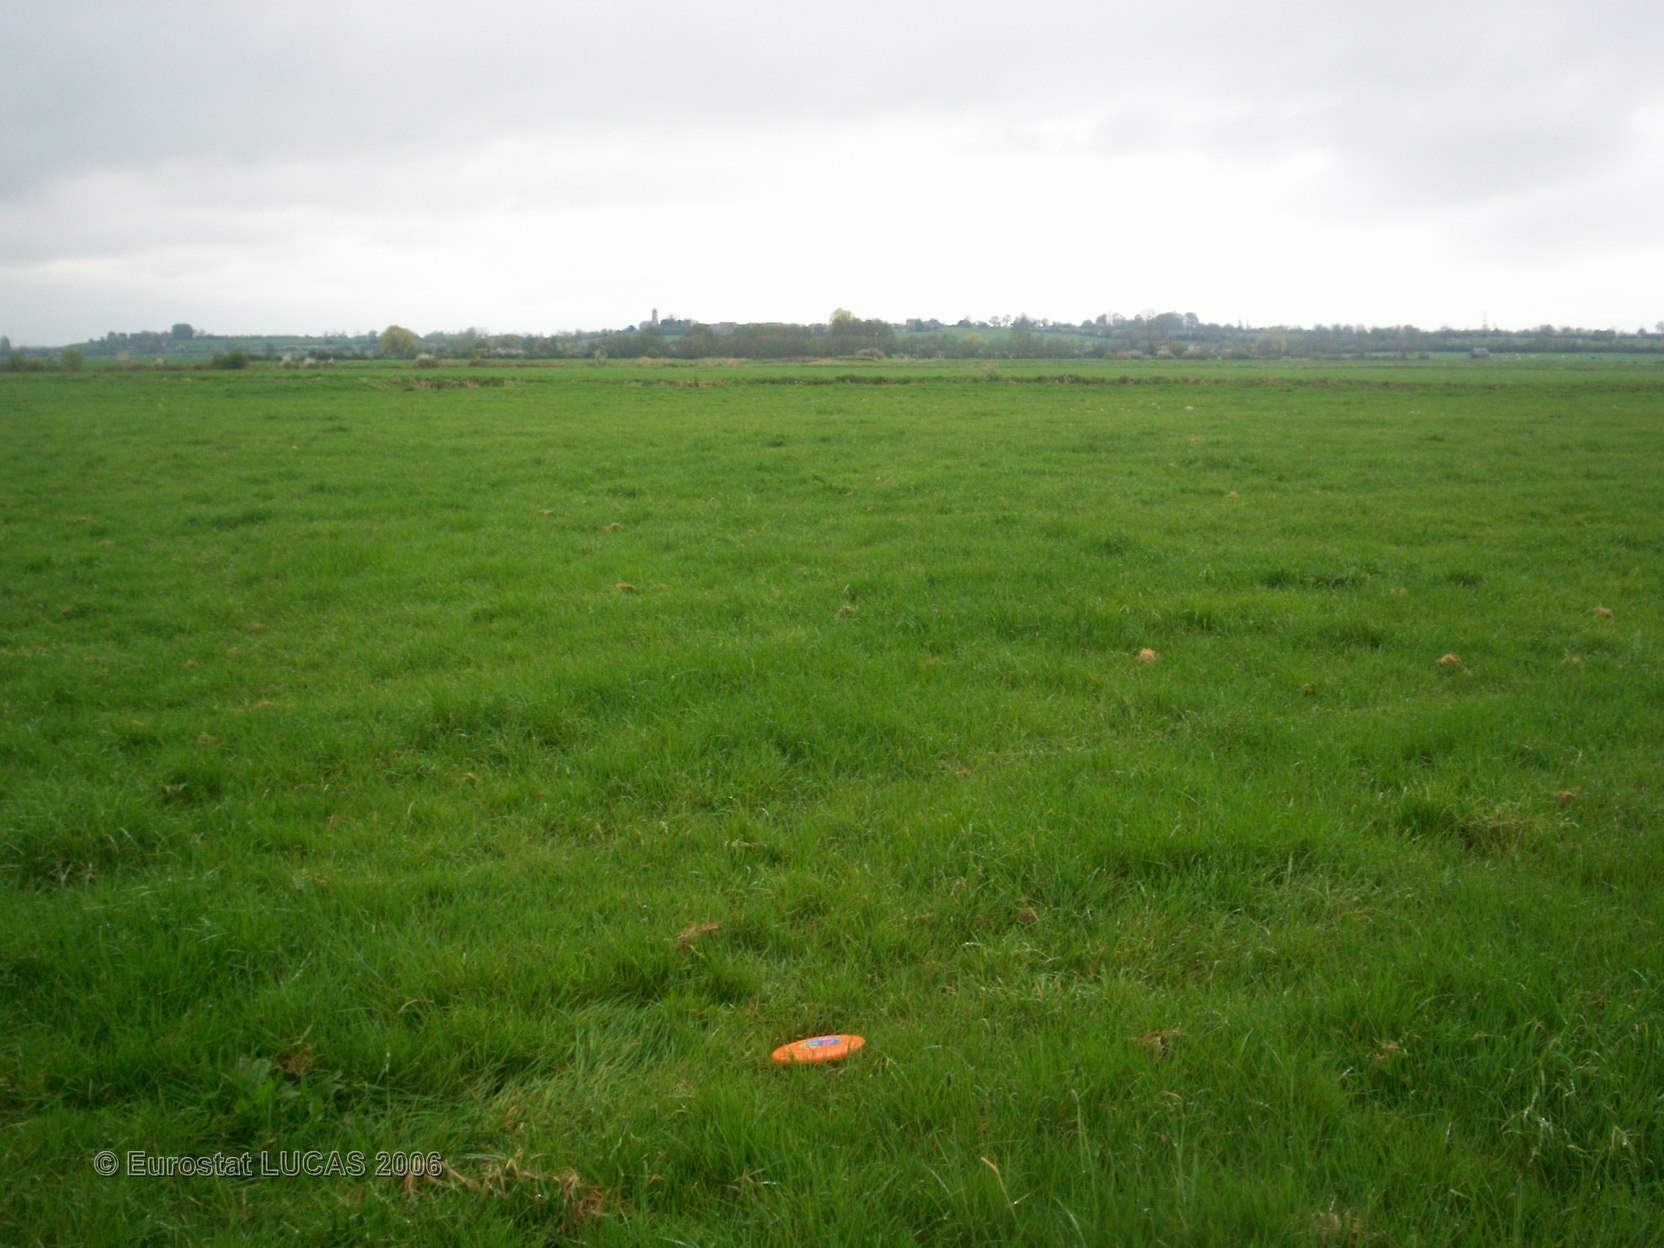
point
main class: Grassland
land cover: Grassland without tree/shrub cover
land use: Agriculture (excluding fallow land and kitchen gardens)
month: April
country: FR
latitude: 49.1610
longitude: -0.0282
